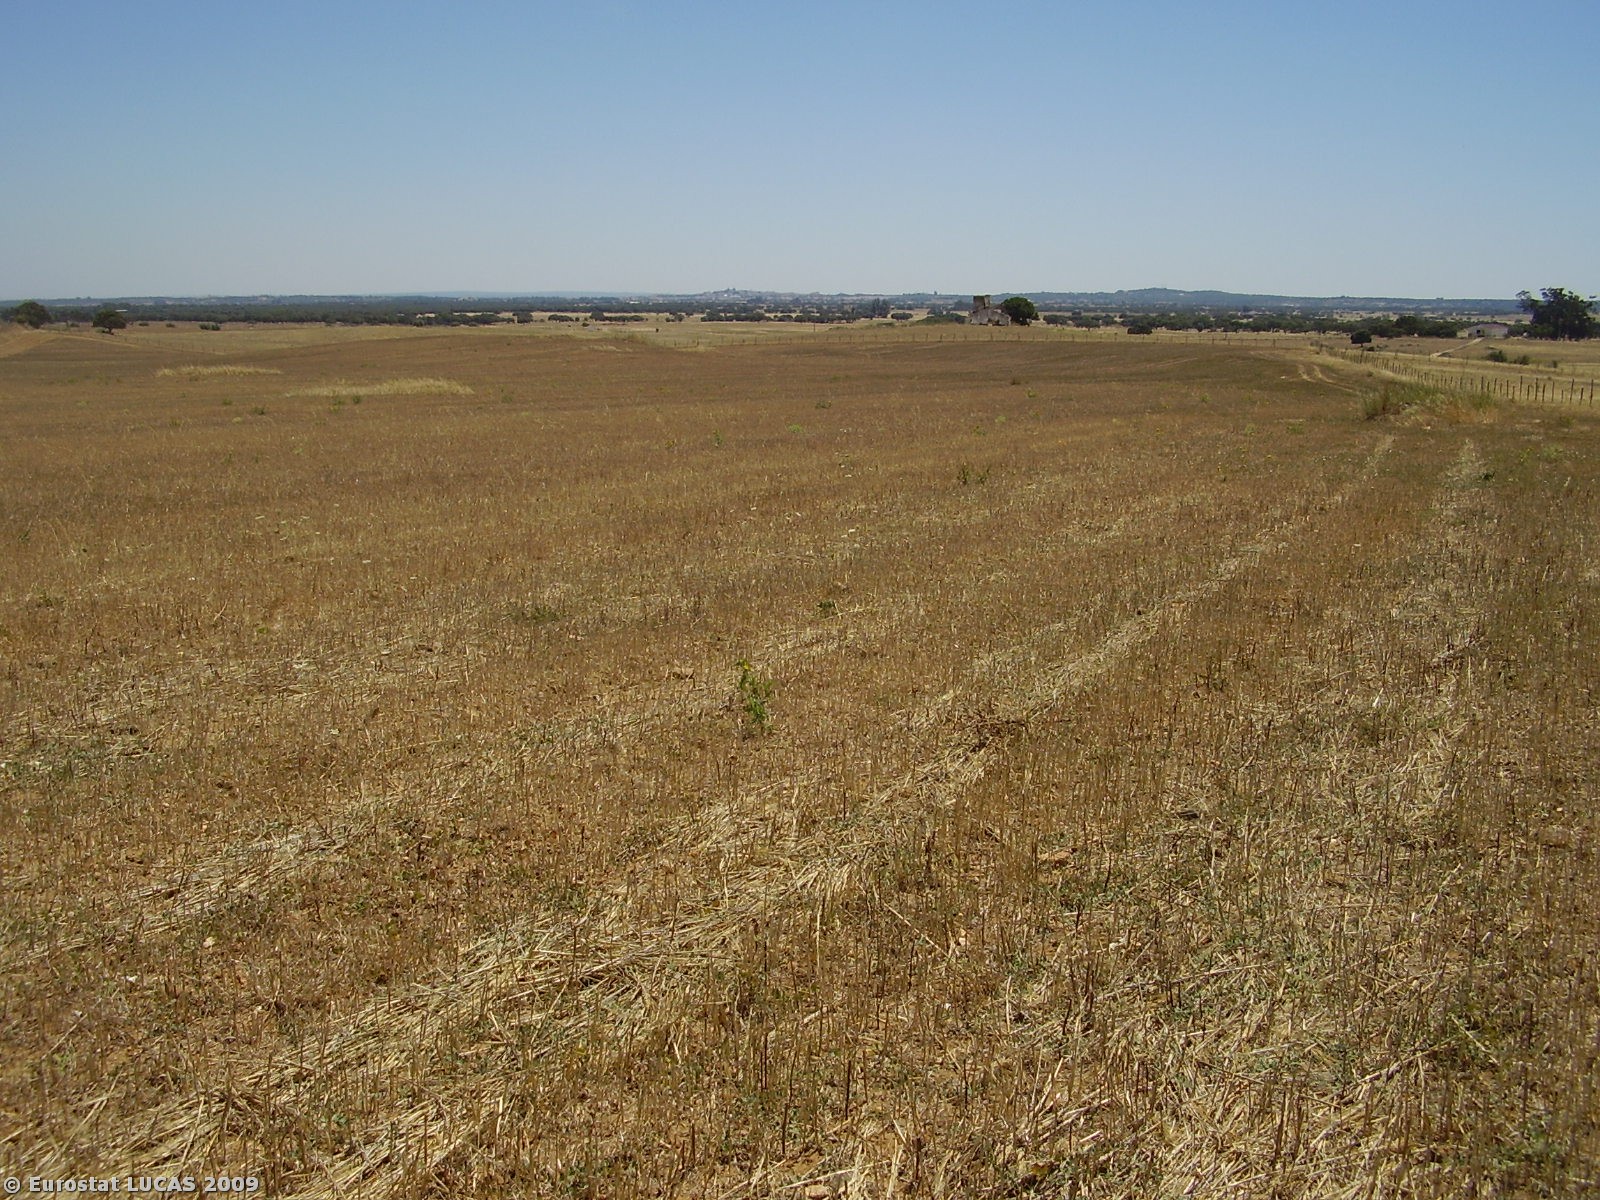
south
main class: Cropland
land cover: Common wheat
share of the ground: > 75 %
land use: Agriculture (excluding fallow land and kitchen gardens)
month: July
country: PT
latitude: 38.6811
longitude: -7.8934
